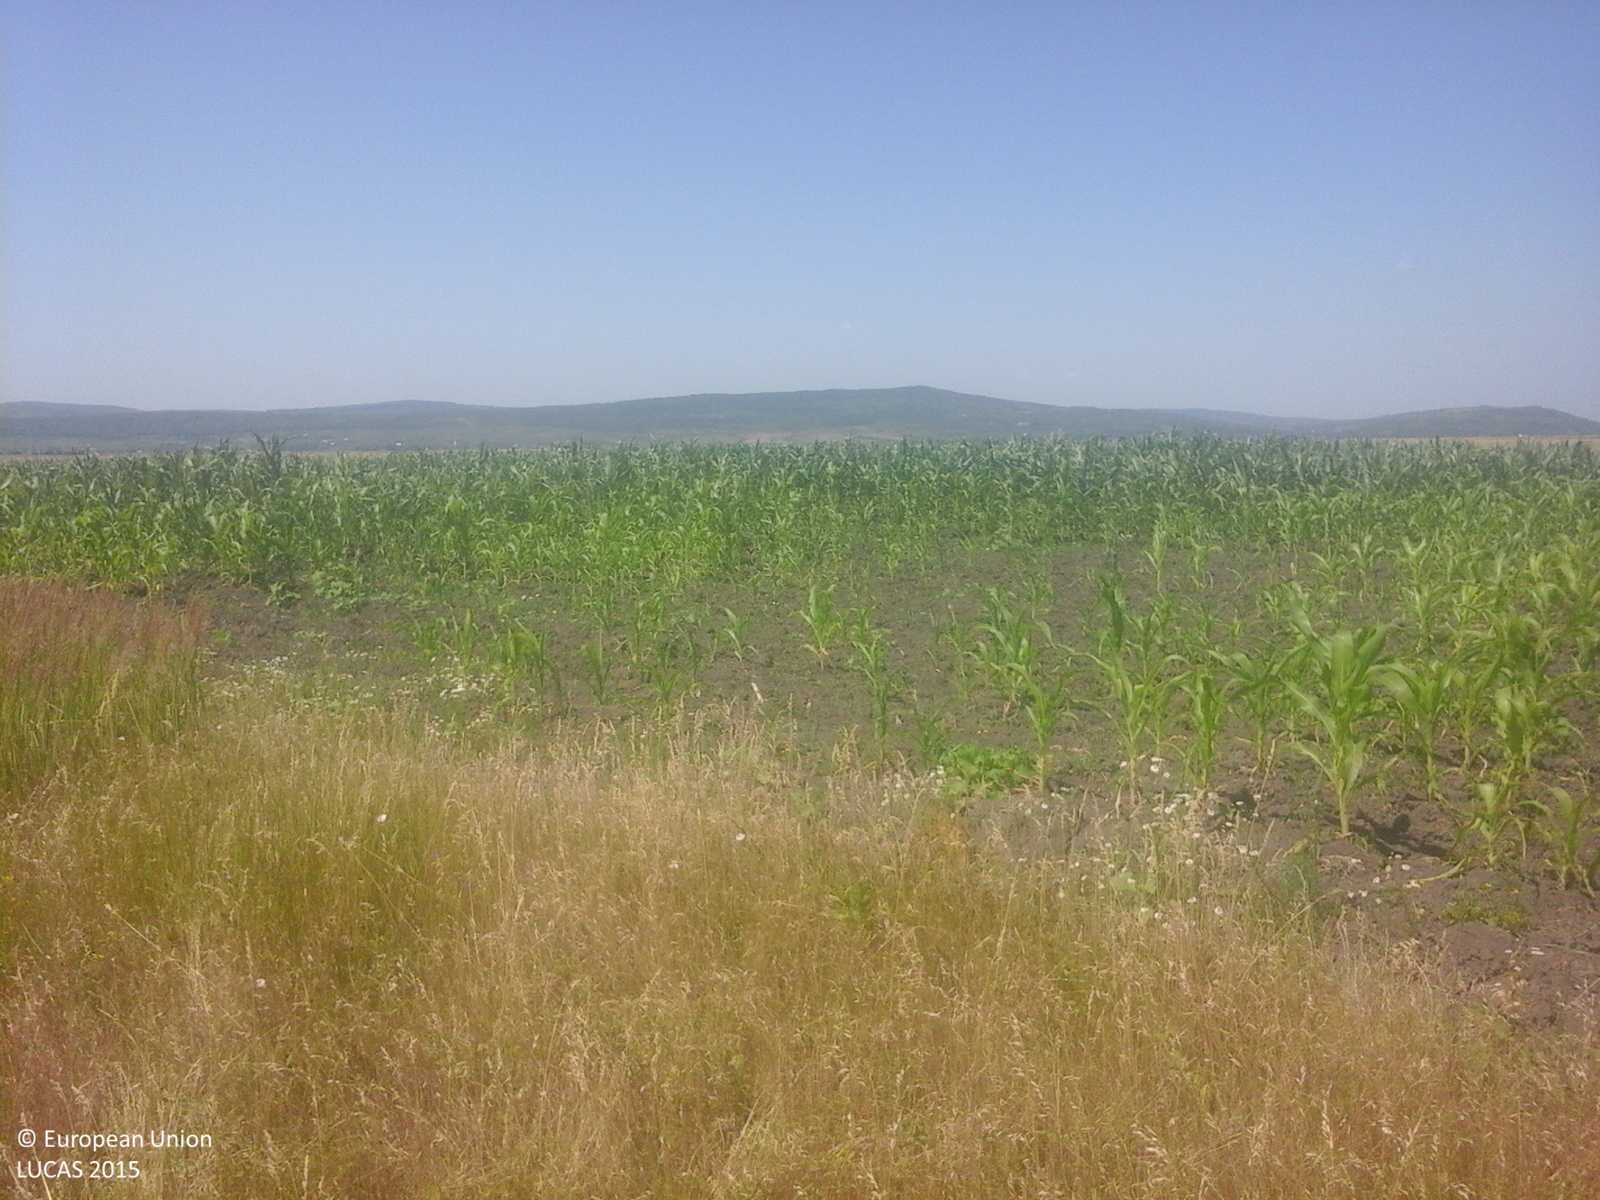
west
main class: Grassland
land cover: Grassland without tree/shrub cover
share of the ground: > 75 %
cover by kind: herbaceous plants 100 %
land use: Agriculture (excluding fallow land and kitchen gardens)
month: June
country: RO
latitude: 47.0793
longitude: 27.8676
